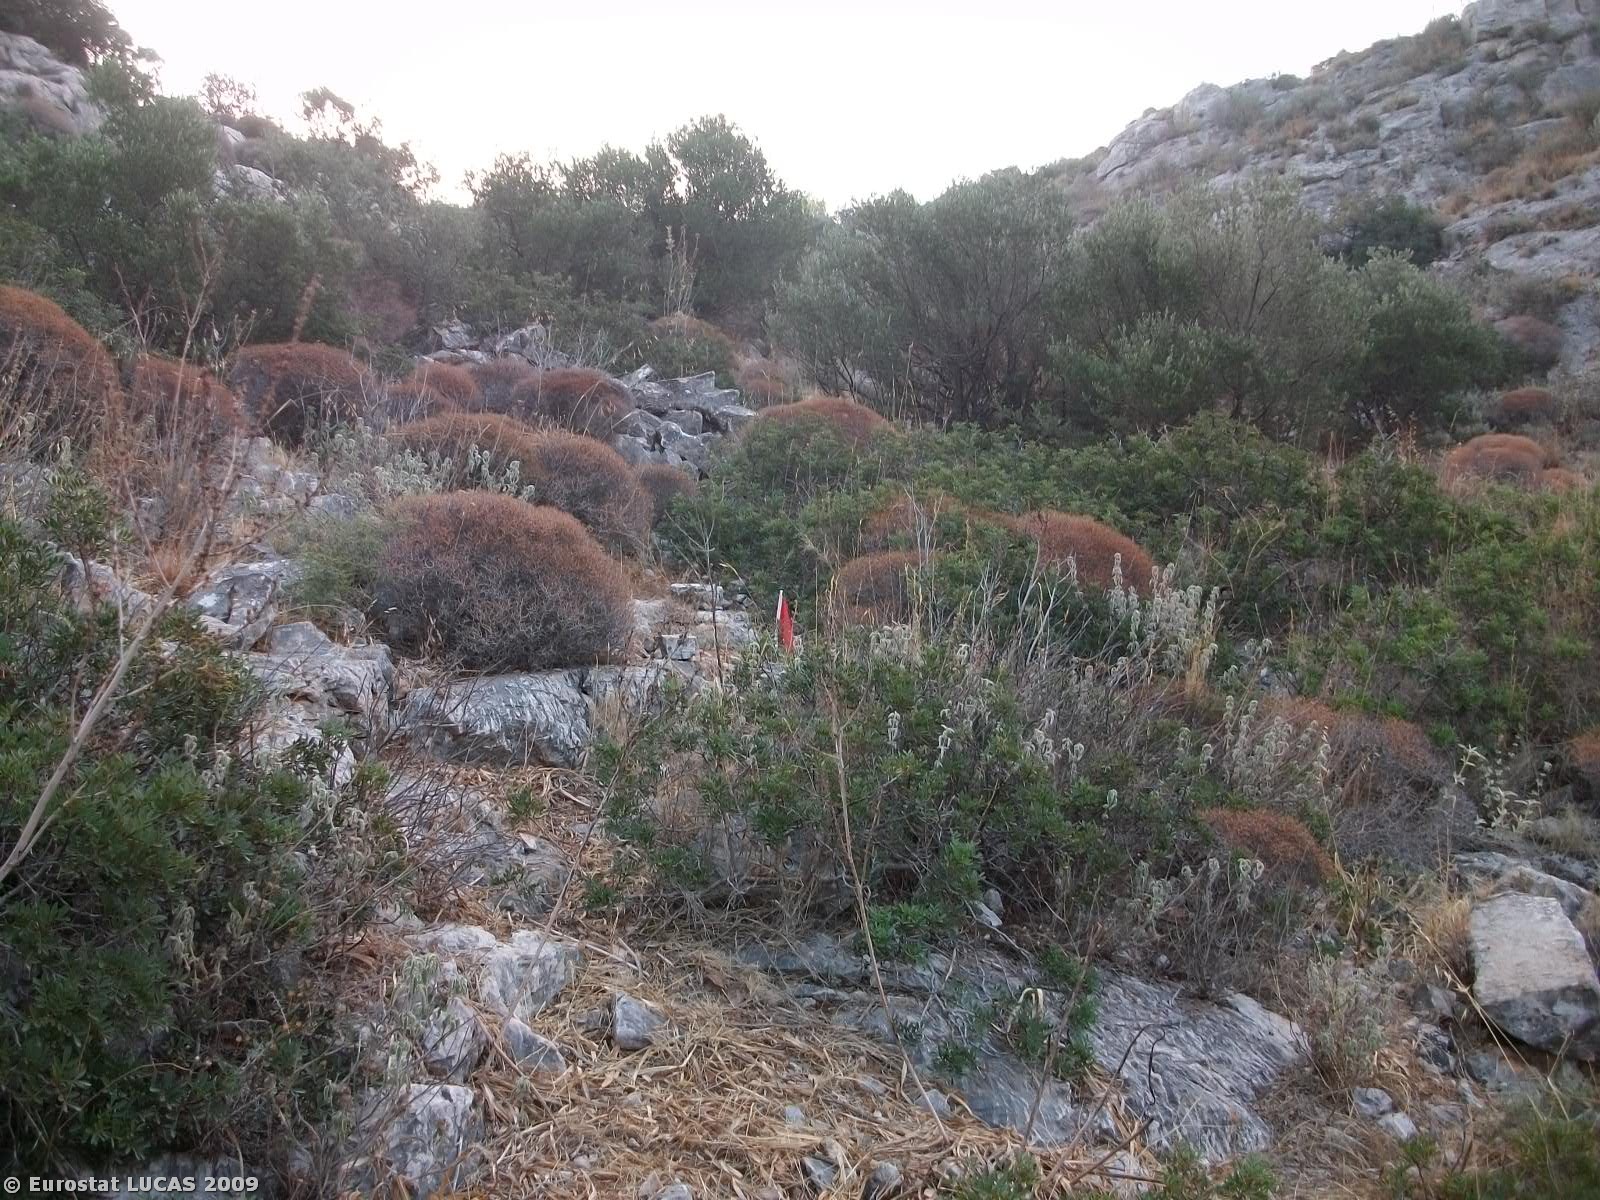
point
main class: Shrubland
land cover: Shrubland with sparse tree cover
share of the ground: 50 - 75 %
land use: Unused
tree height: < 5 m
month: October
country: GR
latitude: 37.8158
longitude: 23.8263
